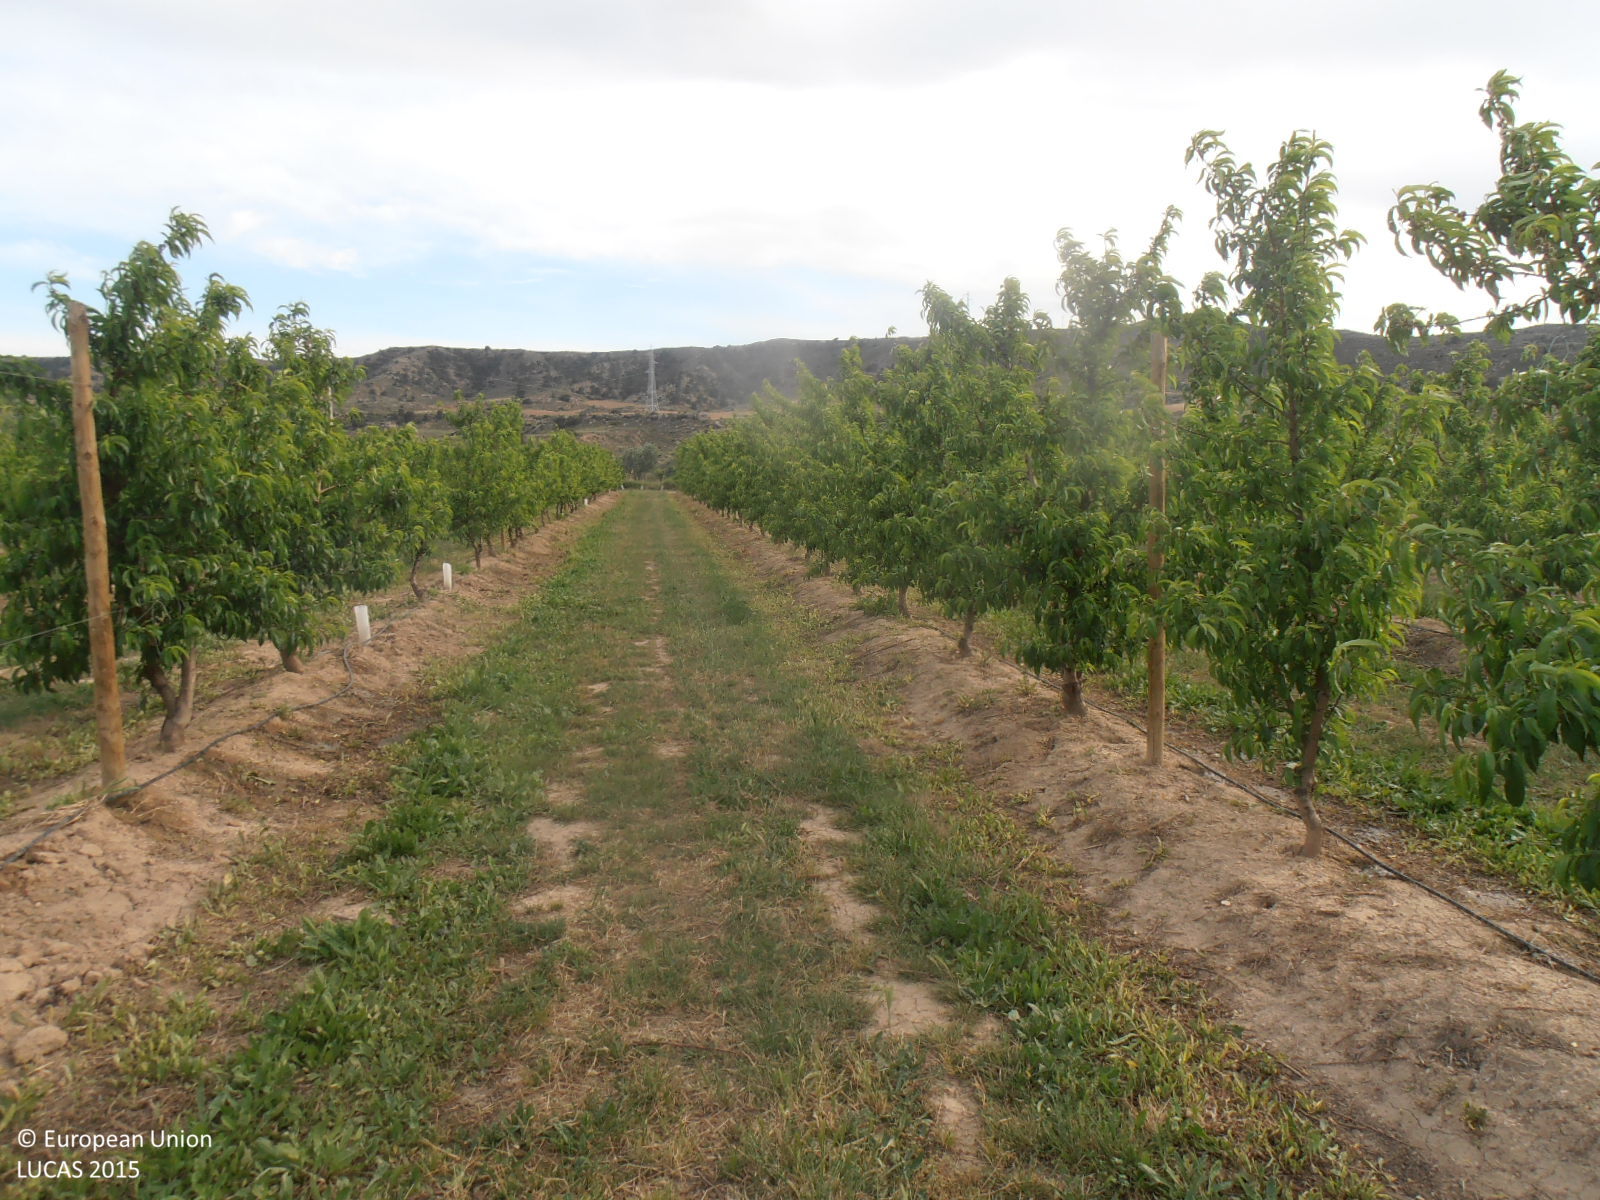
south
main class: Cropland
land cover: Other fruit trees and berries
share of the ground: 50 - 75 %
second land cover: Grassland without tree/shrub cover
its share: > 75 %
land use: Agriculture (excluding fallow land and kitchen gardens)
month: April
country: ES
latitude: 41.2810
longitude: -0.3903
